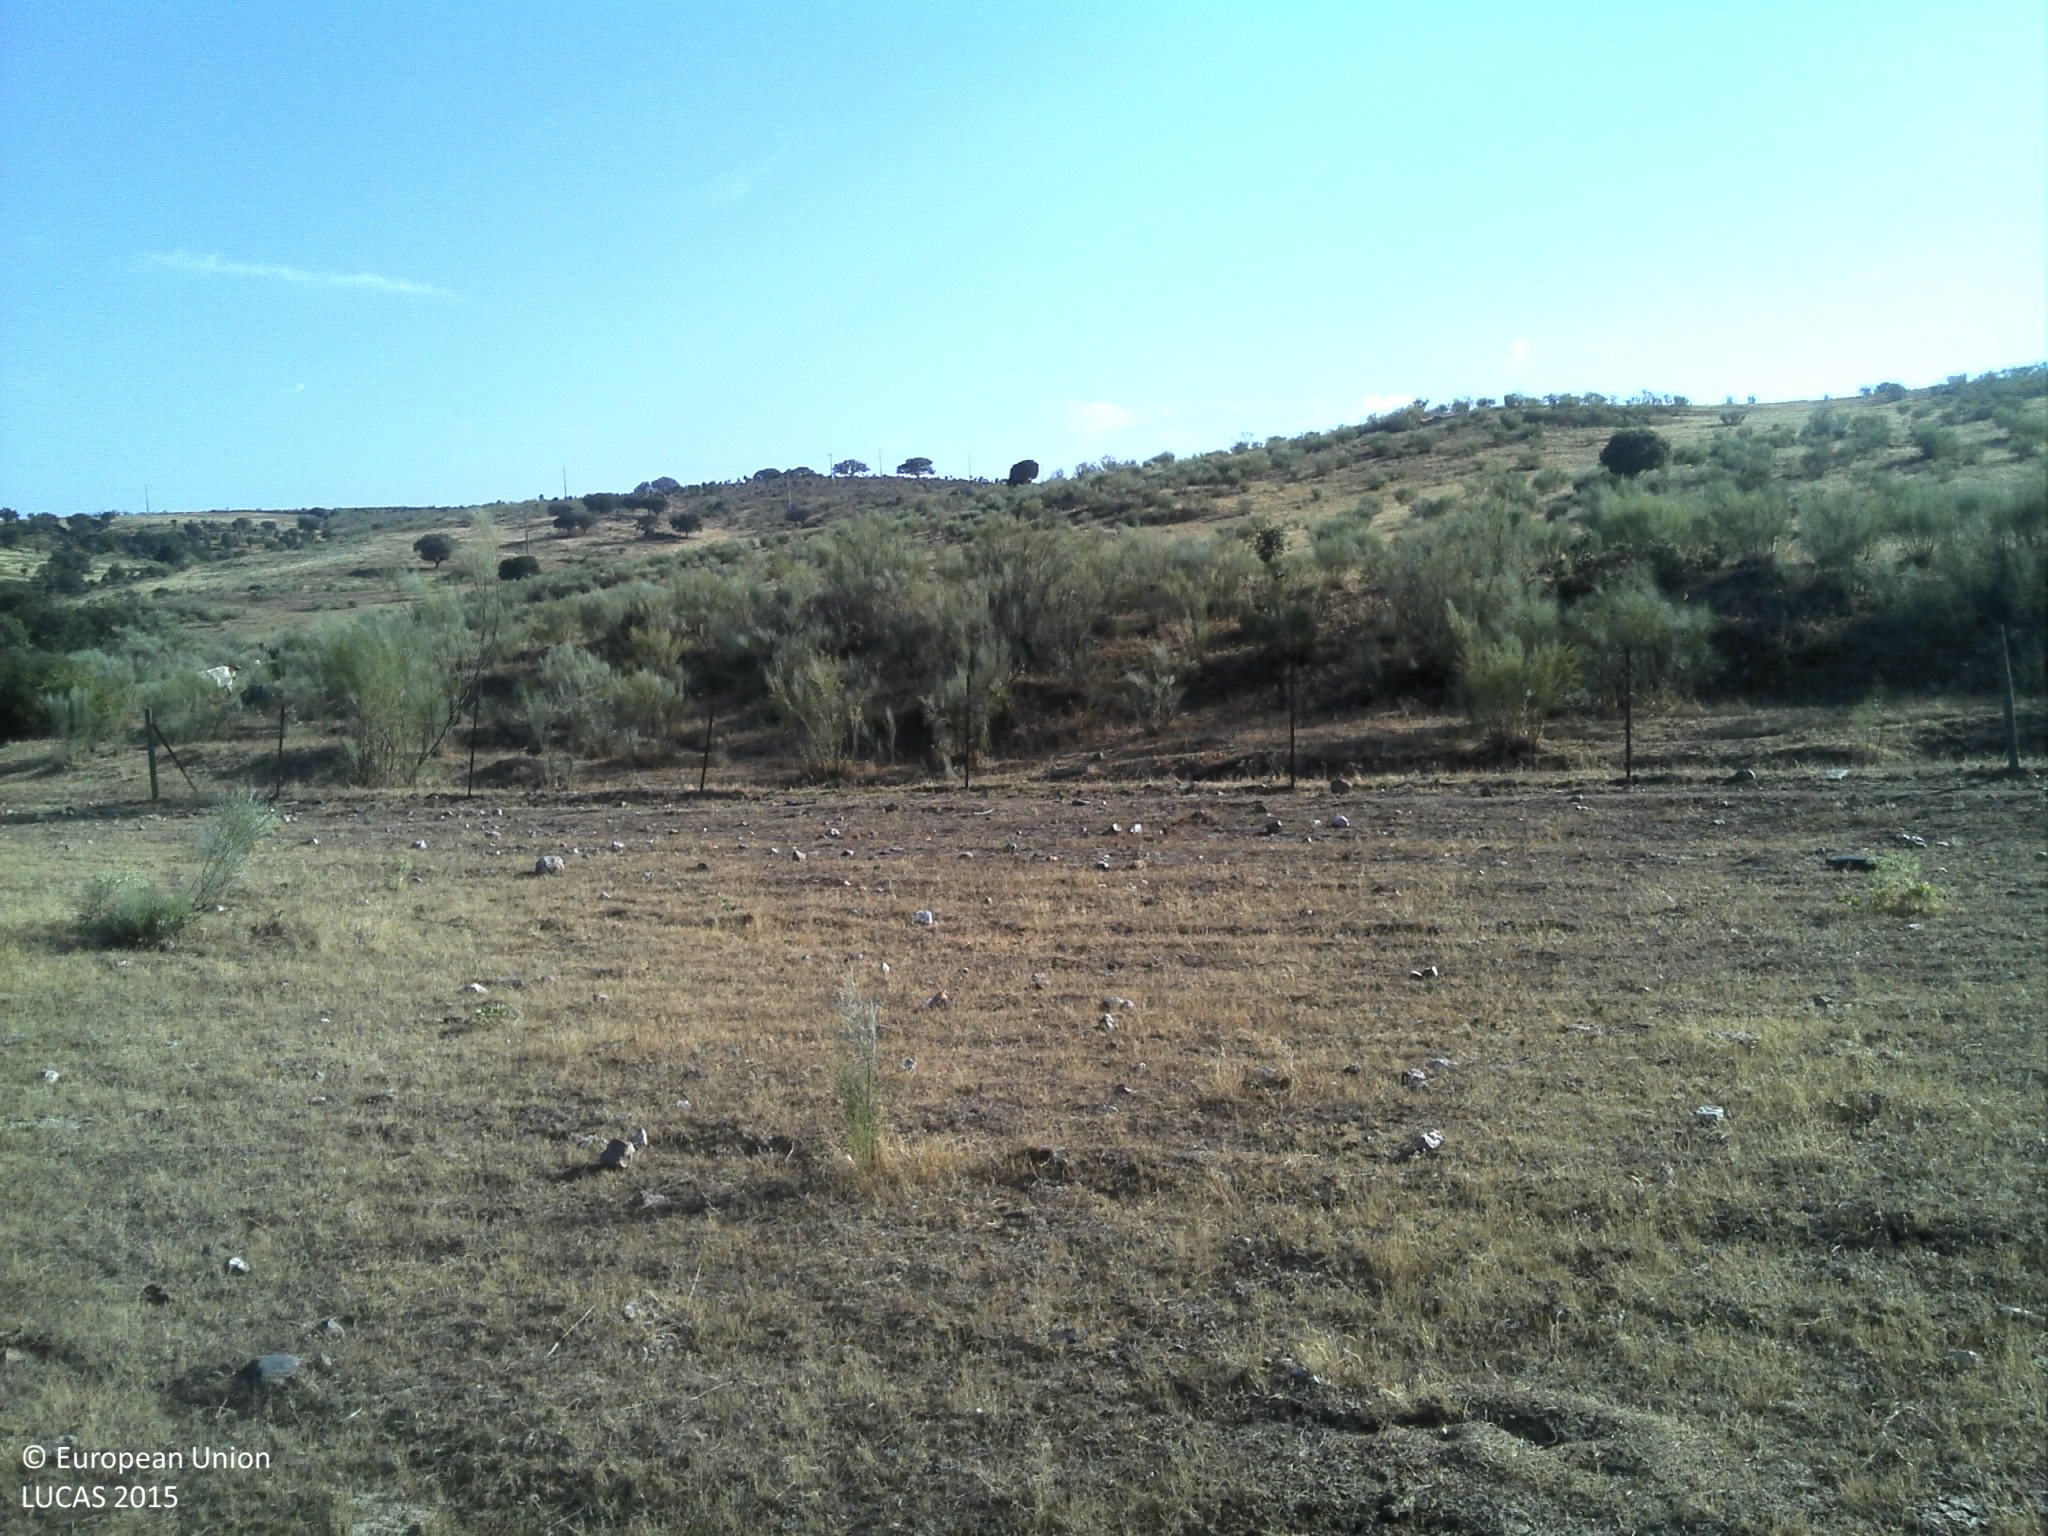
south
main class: Grassland
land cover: Grassland without tree/shrub cover
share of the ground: 10 - 25 %
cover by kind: unconsolidated bare surface 65 %, herbaceous plants 25 %, shrubs 5 %
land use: Agriculture (excluding fallow land and kitchen gardens)
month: June
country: PT
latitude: 39.8237
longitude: -6.9930
